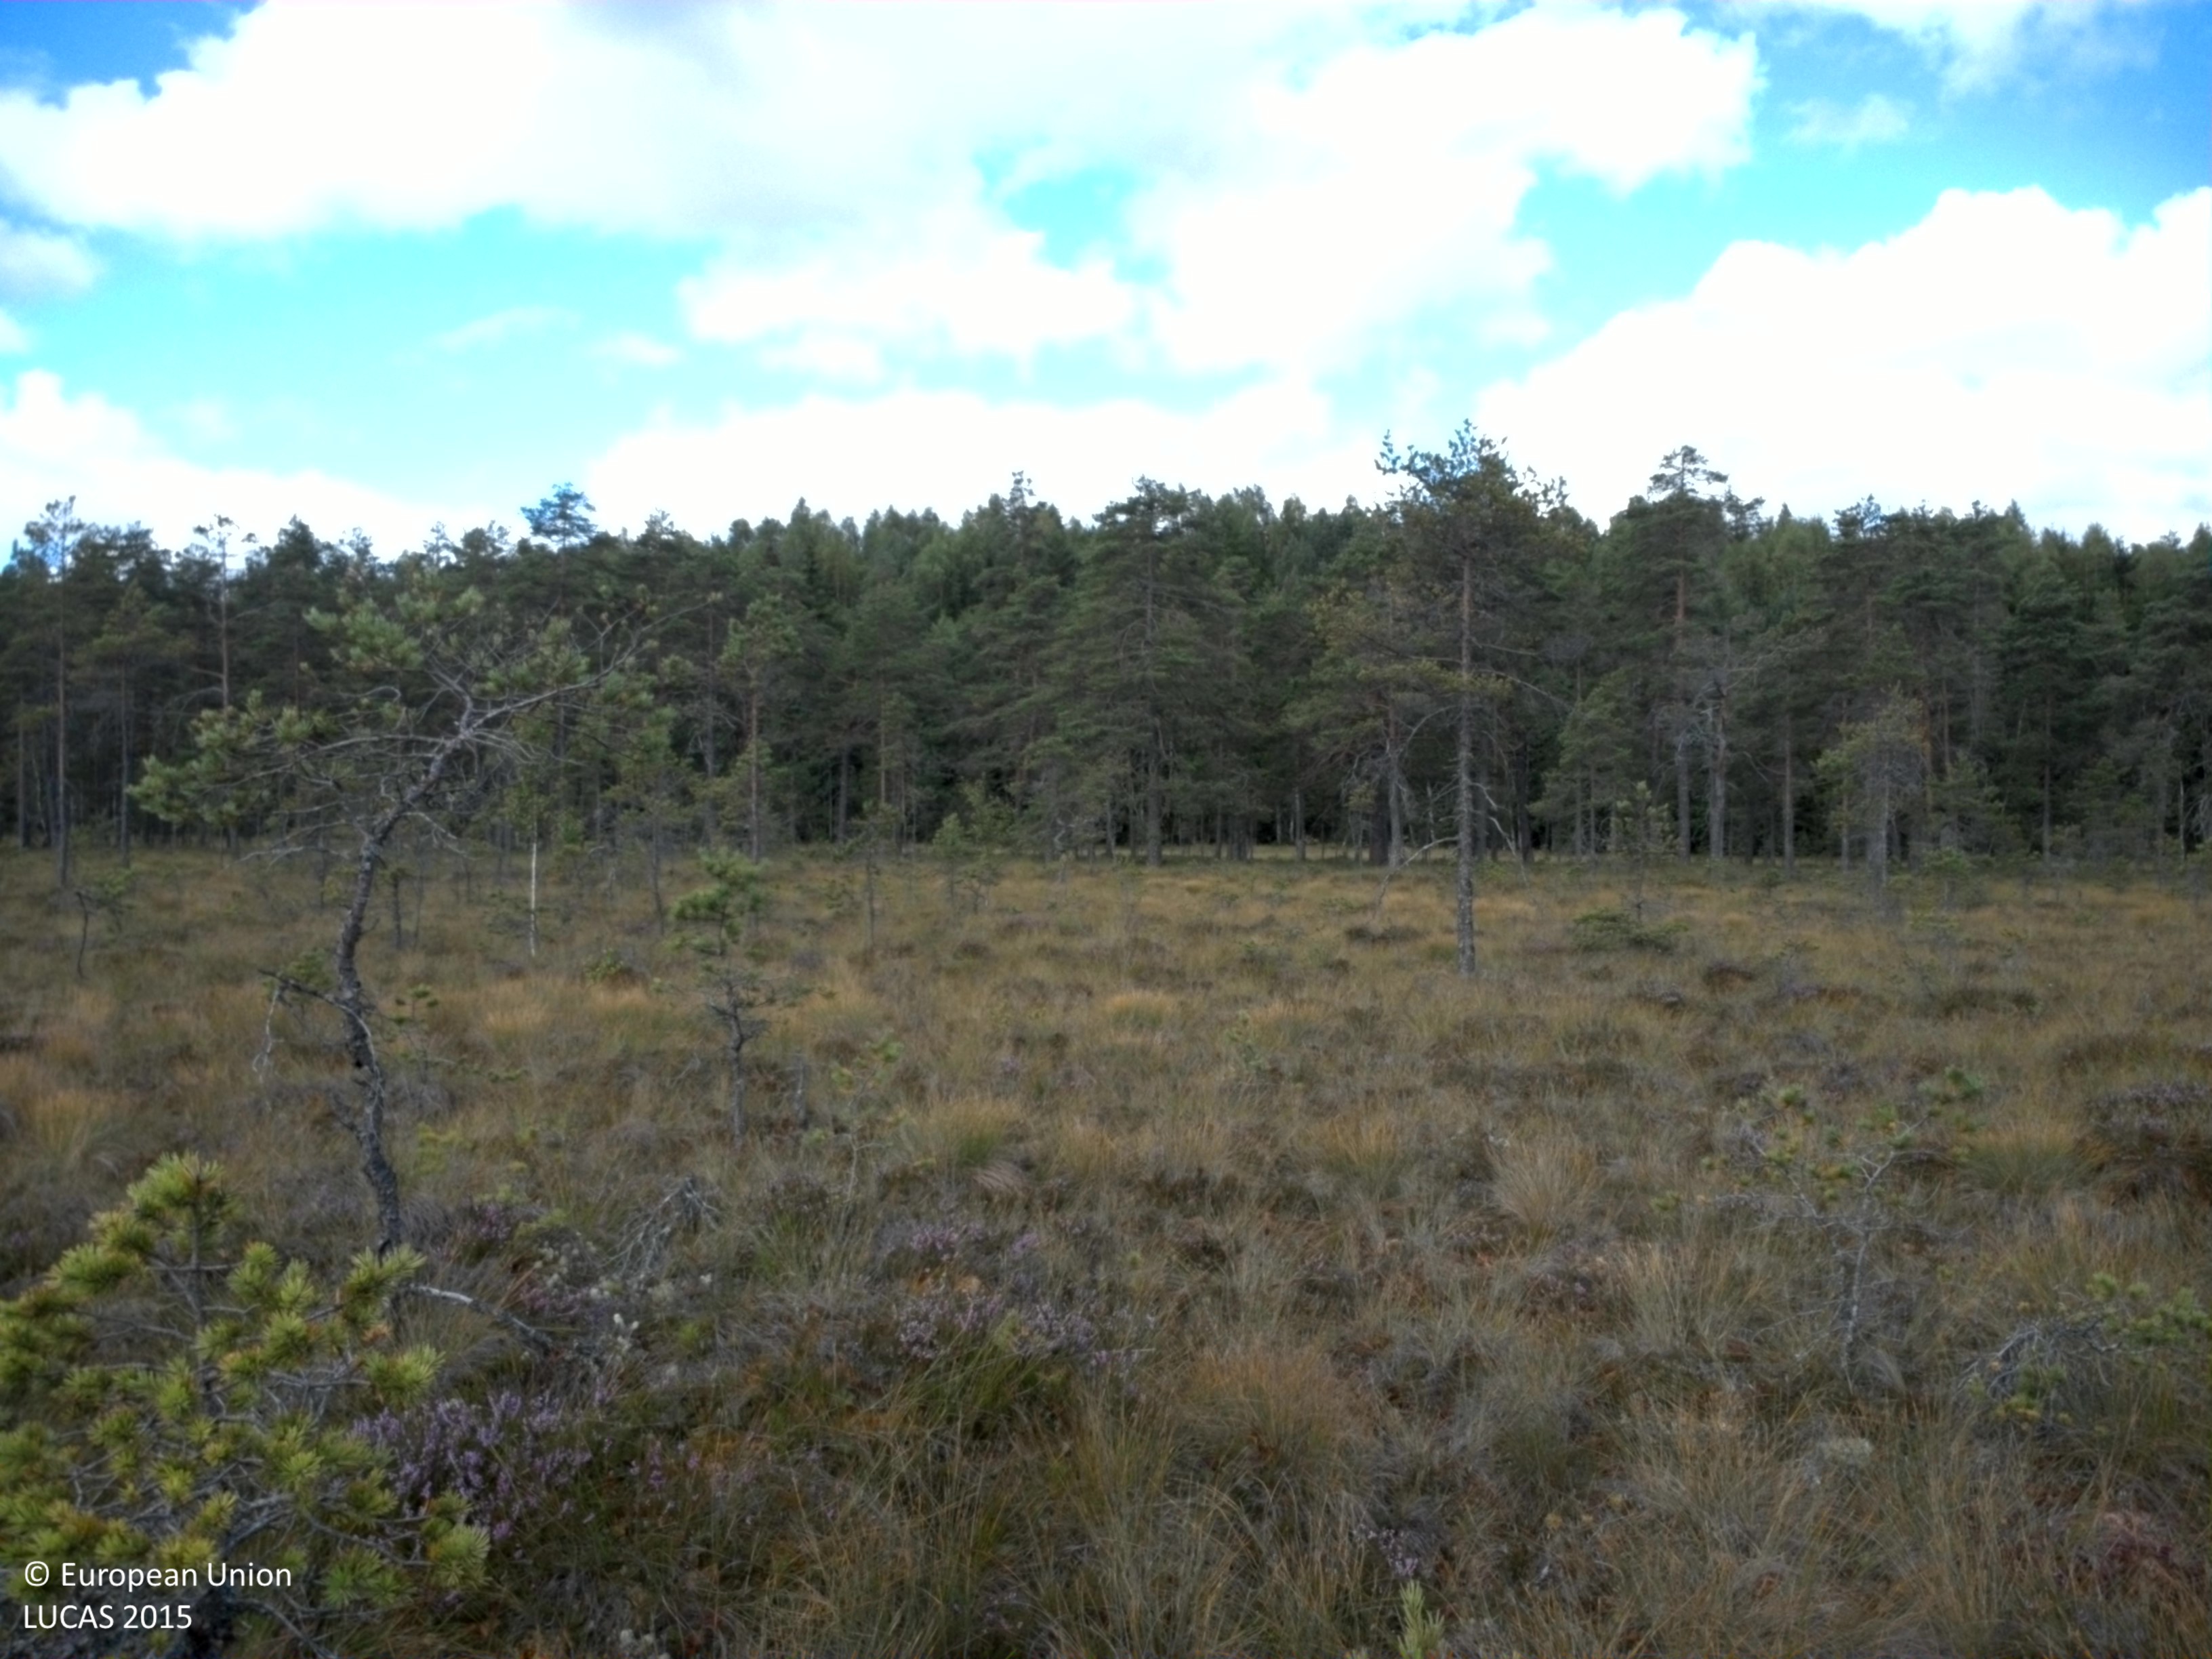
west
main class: Woodland
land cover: Pine dominated coniferous woodland
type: mire and swamp forests
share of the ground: < 10 %
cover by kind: lichens and mosses 40 %, herbaceous plants 30 %, shrubs 20 %, coniferous forest trees 10 %
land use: Semi-natural and natural areas not in use
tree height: < 5 m
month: August
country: SE
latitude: 59.4465
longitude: 11.9877
